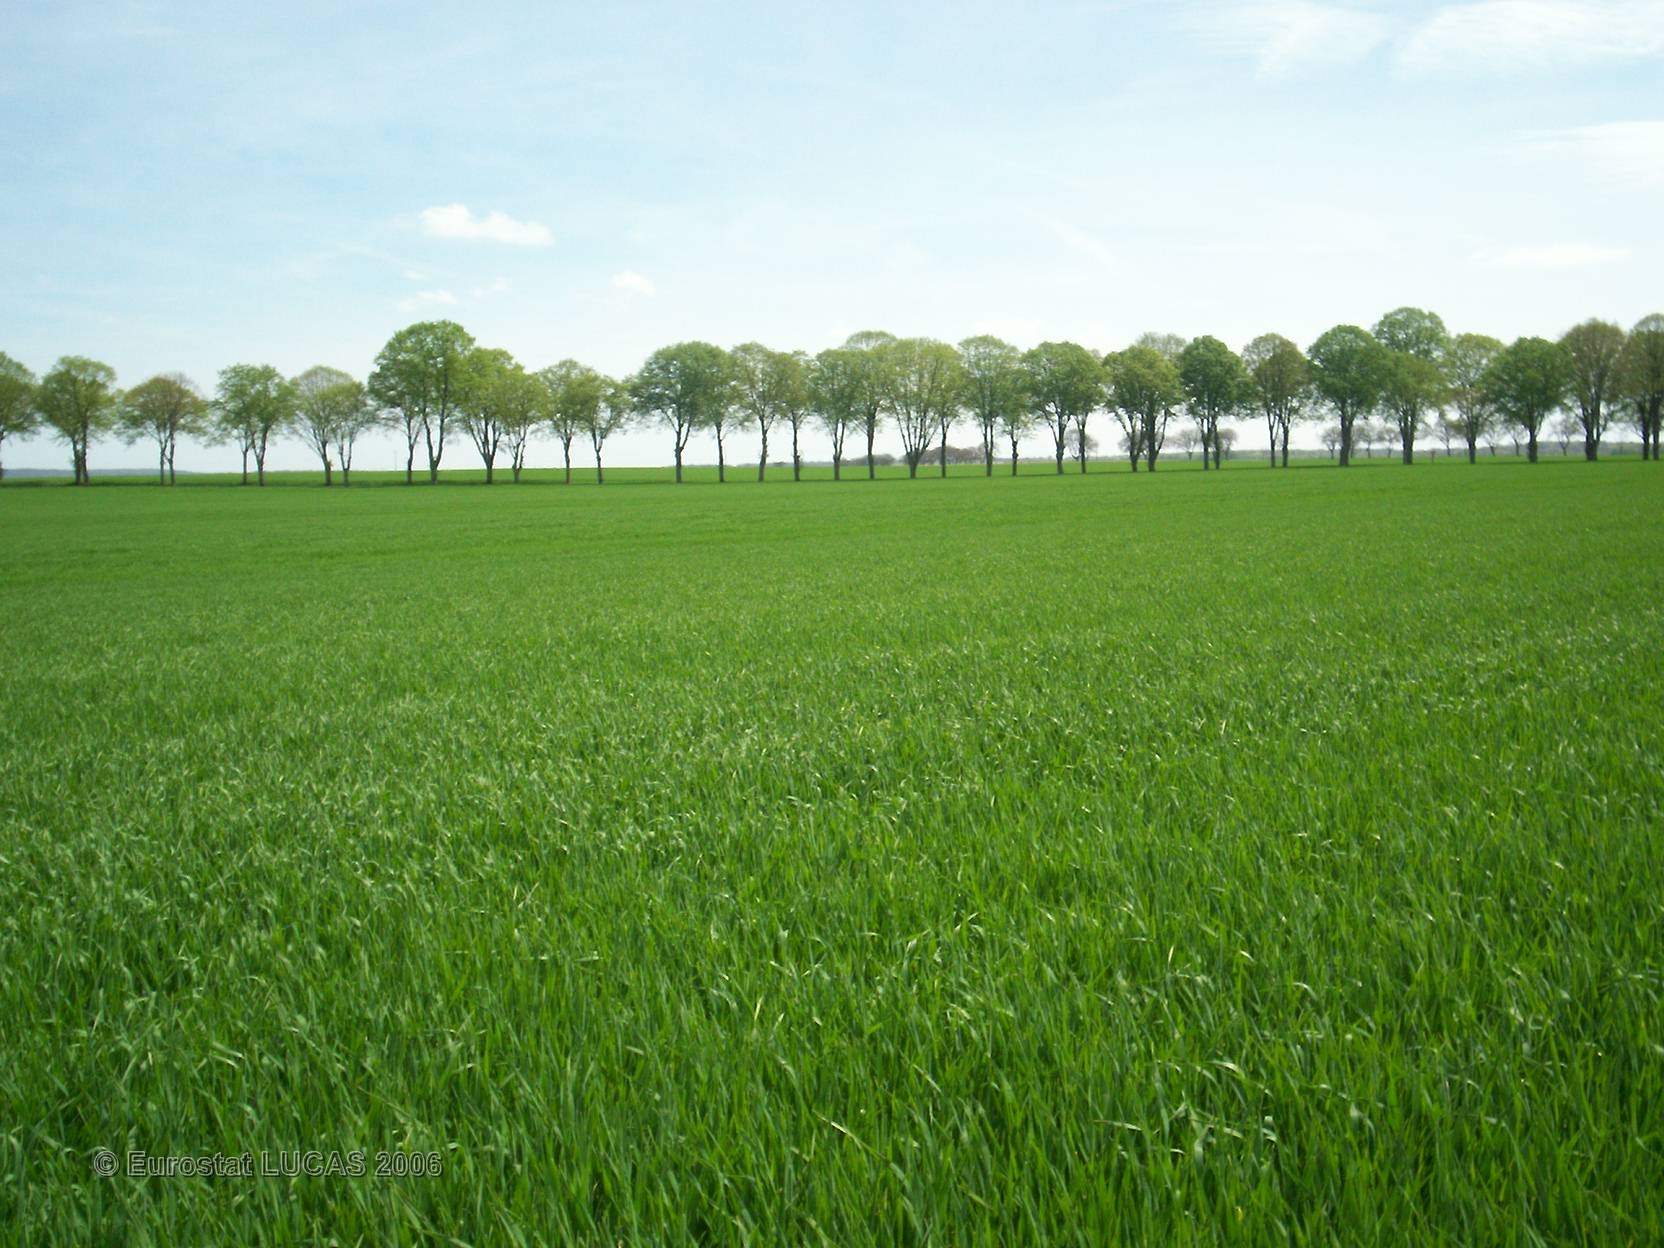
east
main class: Cropland
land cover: Barley
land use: Agriculture (excluding fallow land and kitchen gardens)
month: May
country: FR
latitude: 47.8574
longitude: 4.6121
